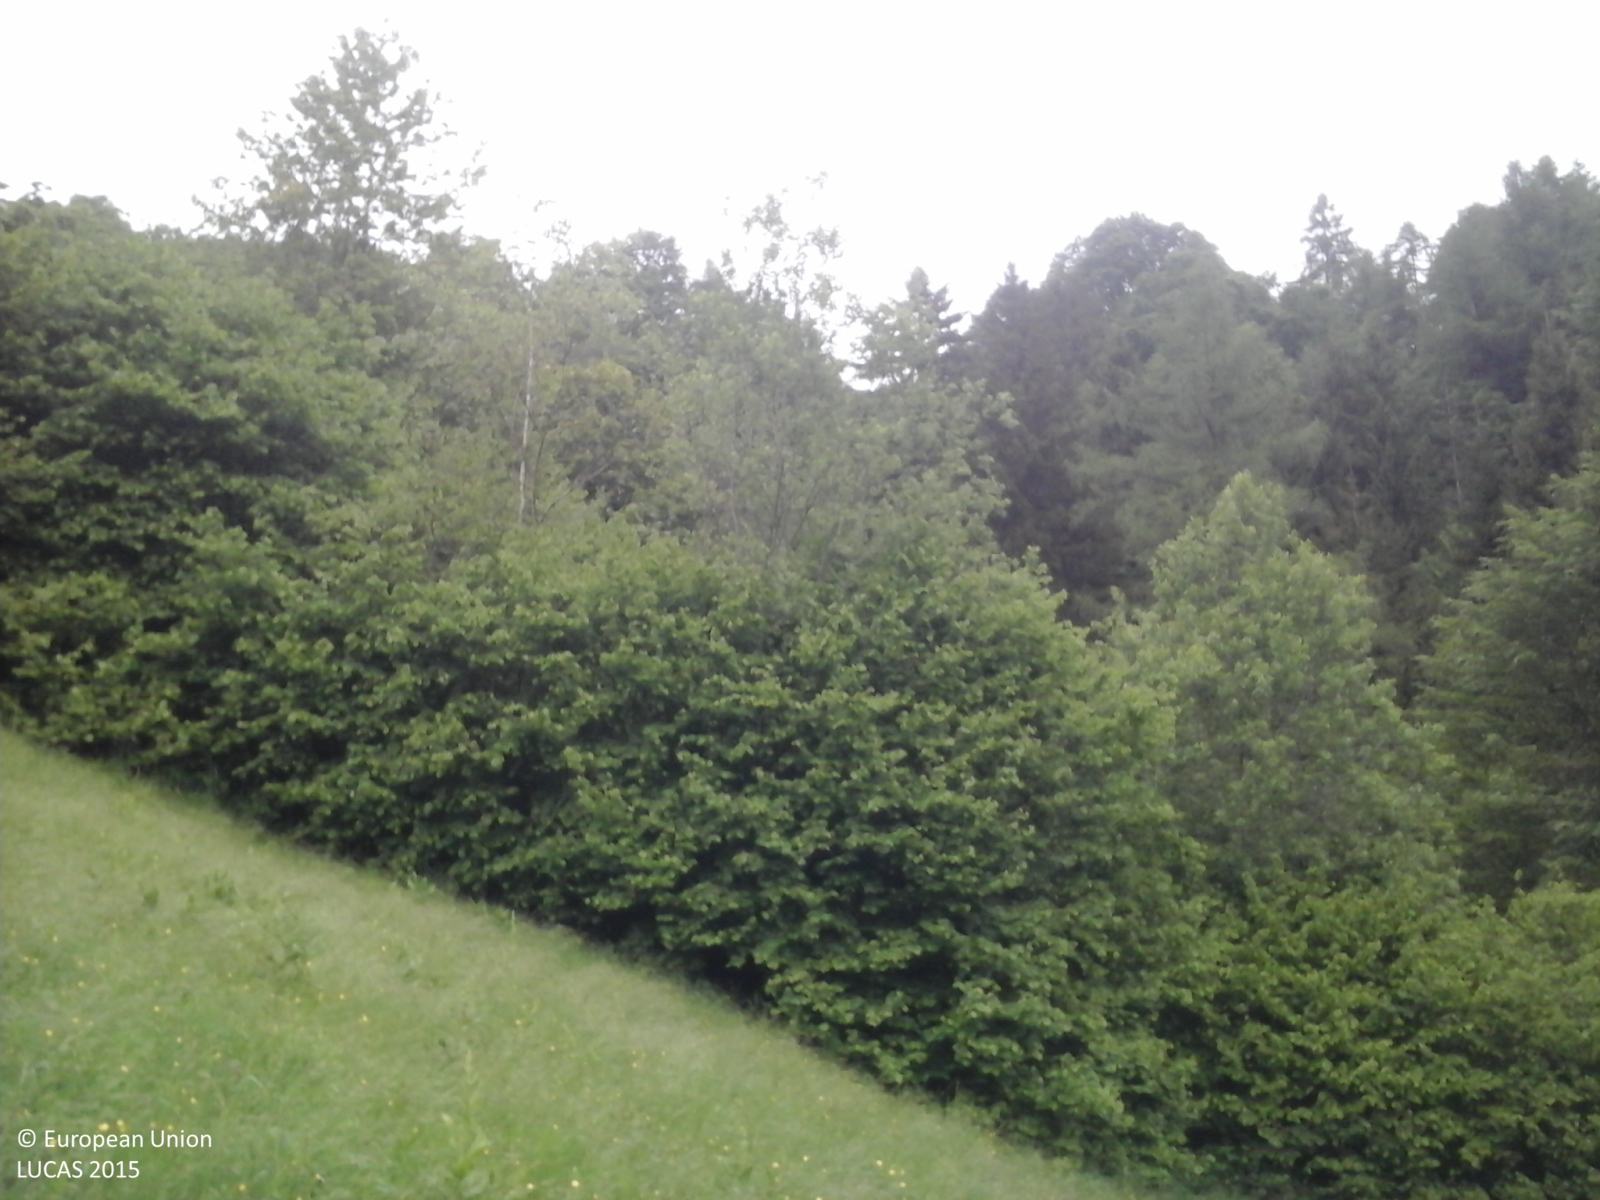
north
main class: Shrubland
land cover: Shrubland without tree cover
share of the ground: > 75 %
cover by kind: herbaceous plants 75 %, shrubs 25 %
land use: Forestry
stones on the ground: < 10 %
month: May
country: IT
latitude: 45.7350
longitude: 10.8853
